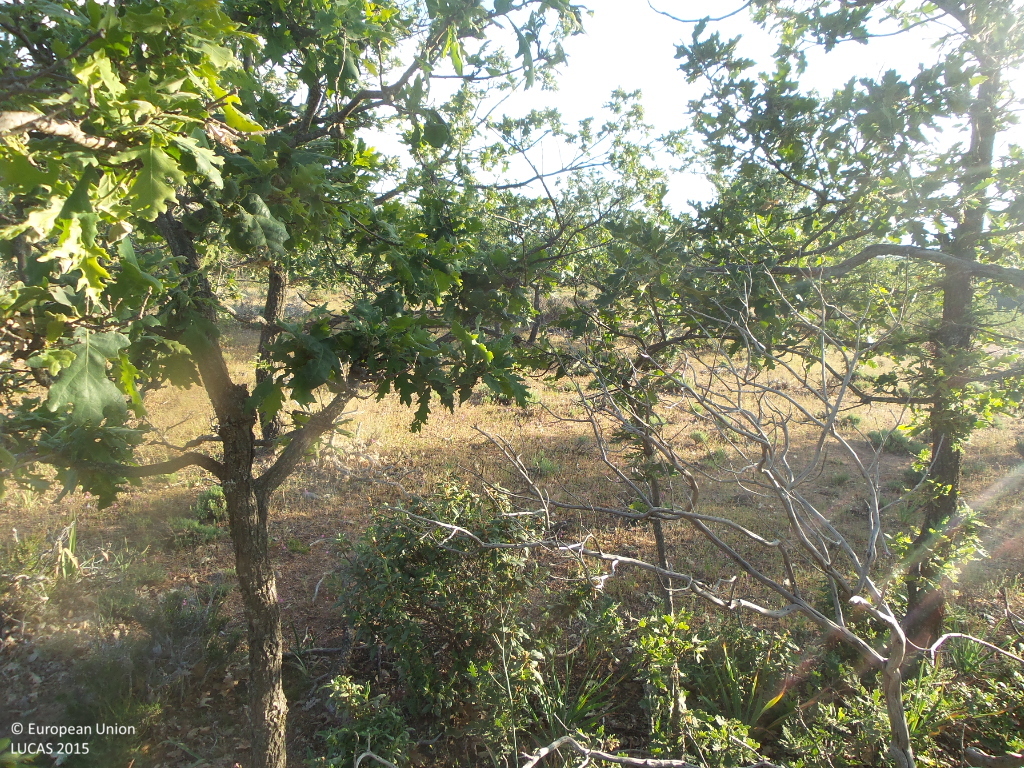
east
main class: Woodland
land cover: Broadleaved woodland
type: thermophilous deciduous forest
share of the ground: 50 - 75 %
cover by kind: broadleaved forest trees 50 %, shrubs 15 %, herbaceous plants 15 %, unconsolidated bare surface 15 %, lichens and mosses 5 %
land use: Semi-natural and natural areas not in use
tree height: < 5 m
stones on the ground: < 10 %
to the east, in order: Broadleaved woodland; Tracks; Shrubland without tree cover; Broadleaved woodland; Grassland with sparse tree/shrub cover; Shrubland with sparse tree cover; Rock outcrops; Broadleaved woodland; Rock outcrops; Broadleaved woodland; Rocks and stones
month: June
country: ES
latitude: 41.3032
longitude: -3.1188
